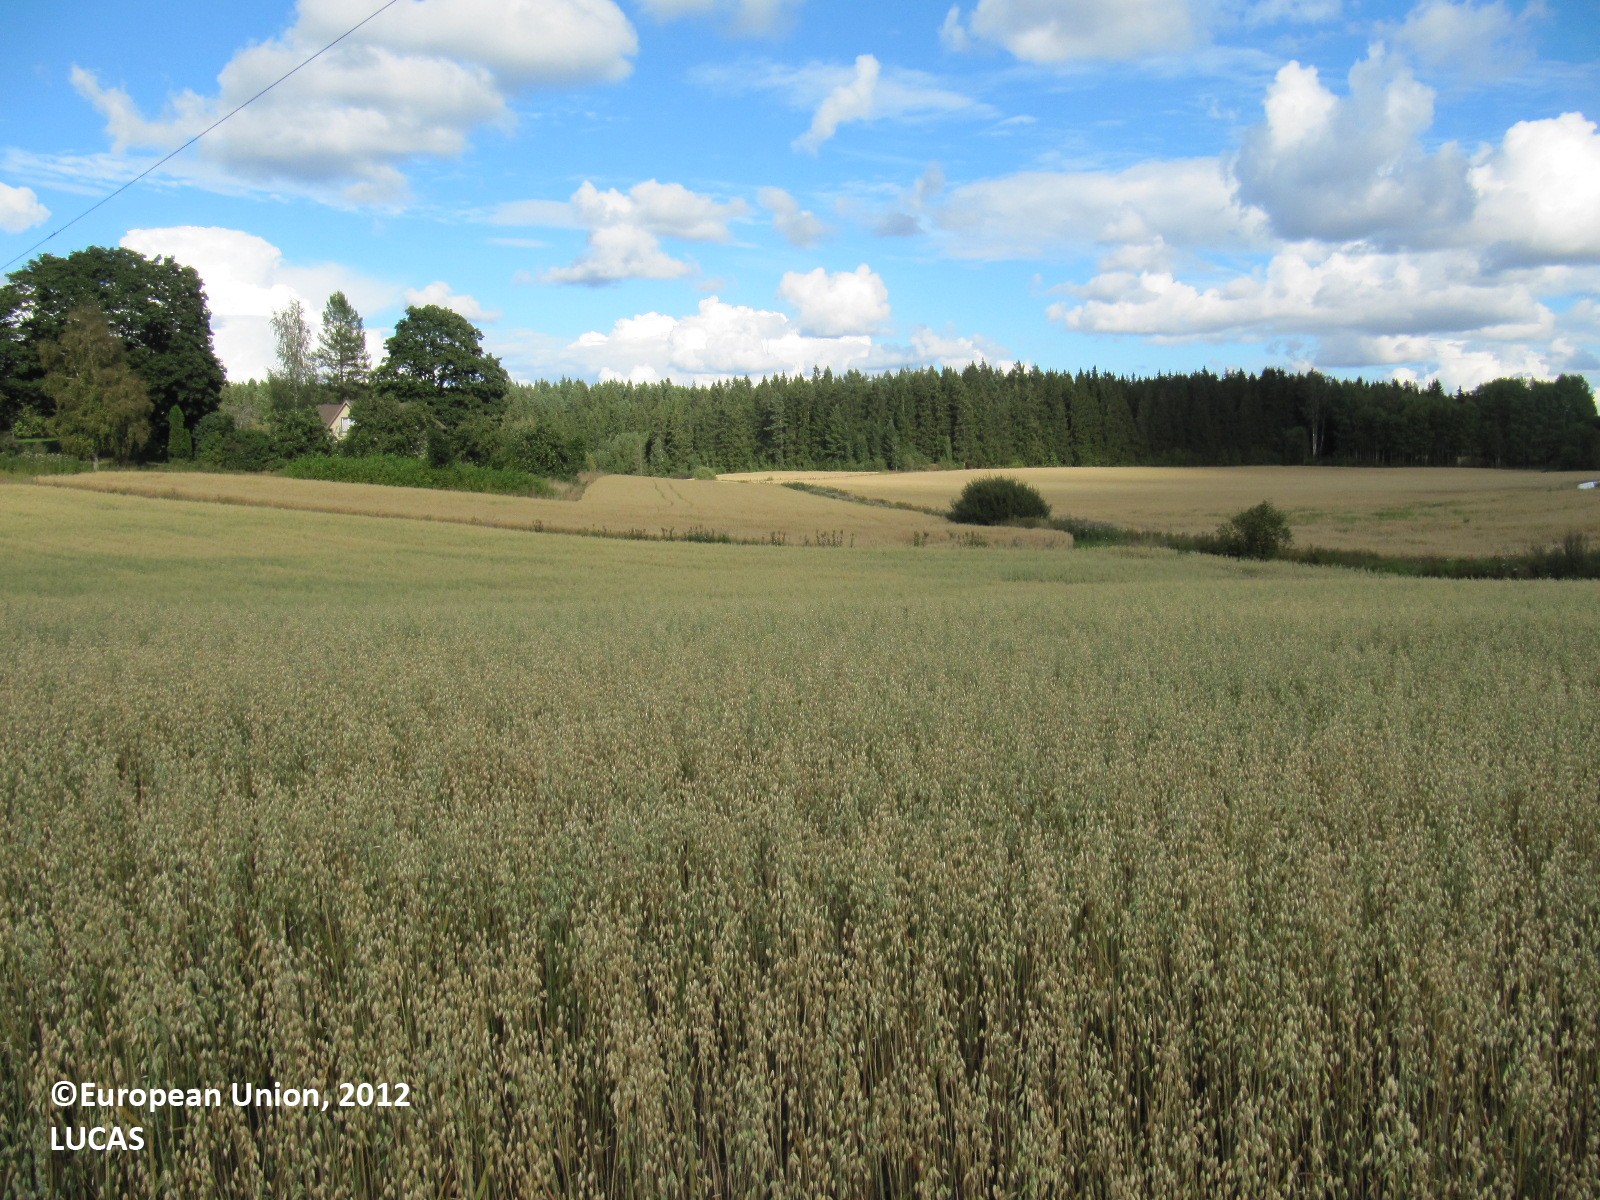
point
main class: Cropland
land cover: Oats
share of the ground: > 75 %
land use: Agriculture (excluding fallow land and kitchen gardens)
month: August
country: FI
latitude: 60.1603
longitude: 23.7692
